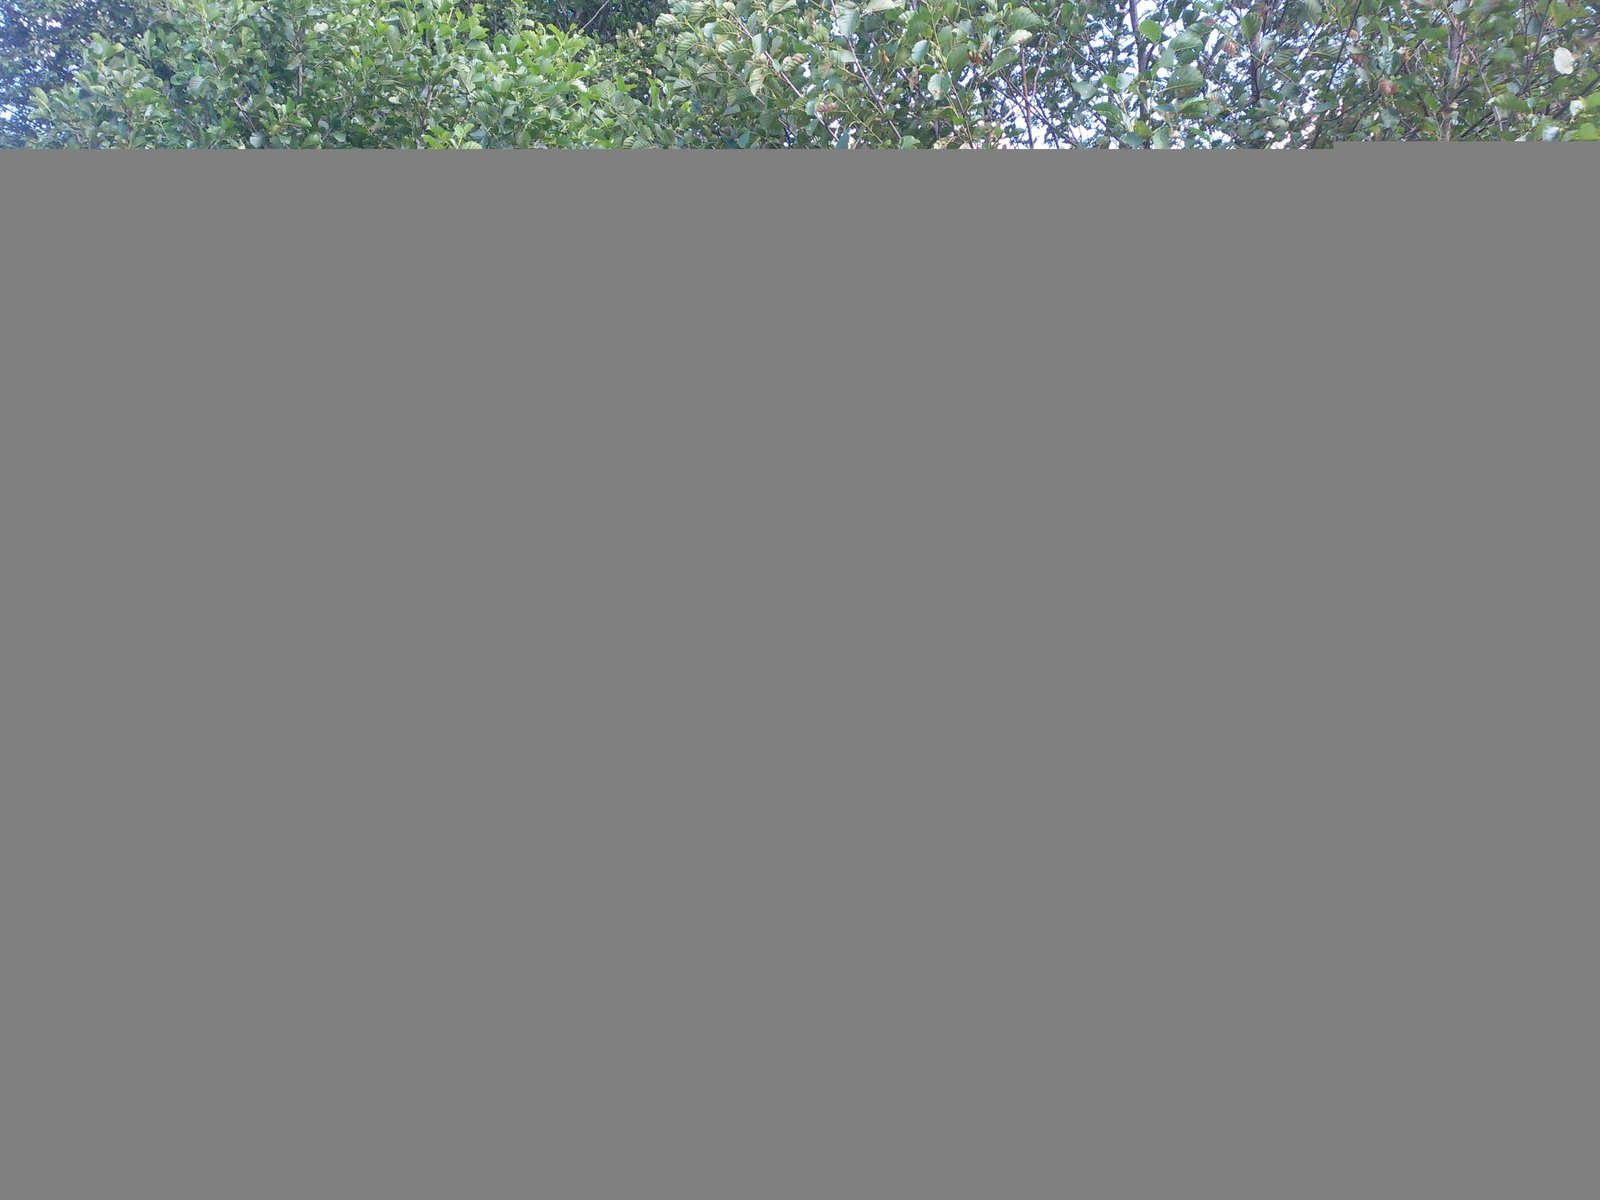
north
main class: Grassland
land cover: Spontaneously vegetated surfaces
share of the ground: > 75 %
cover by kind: herbaceous plants 95 %, shrubs 5 %
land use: Semi-natural and natural areas not in use
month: July
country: PL
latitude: 52.8932
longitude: 19.1355
